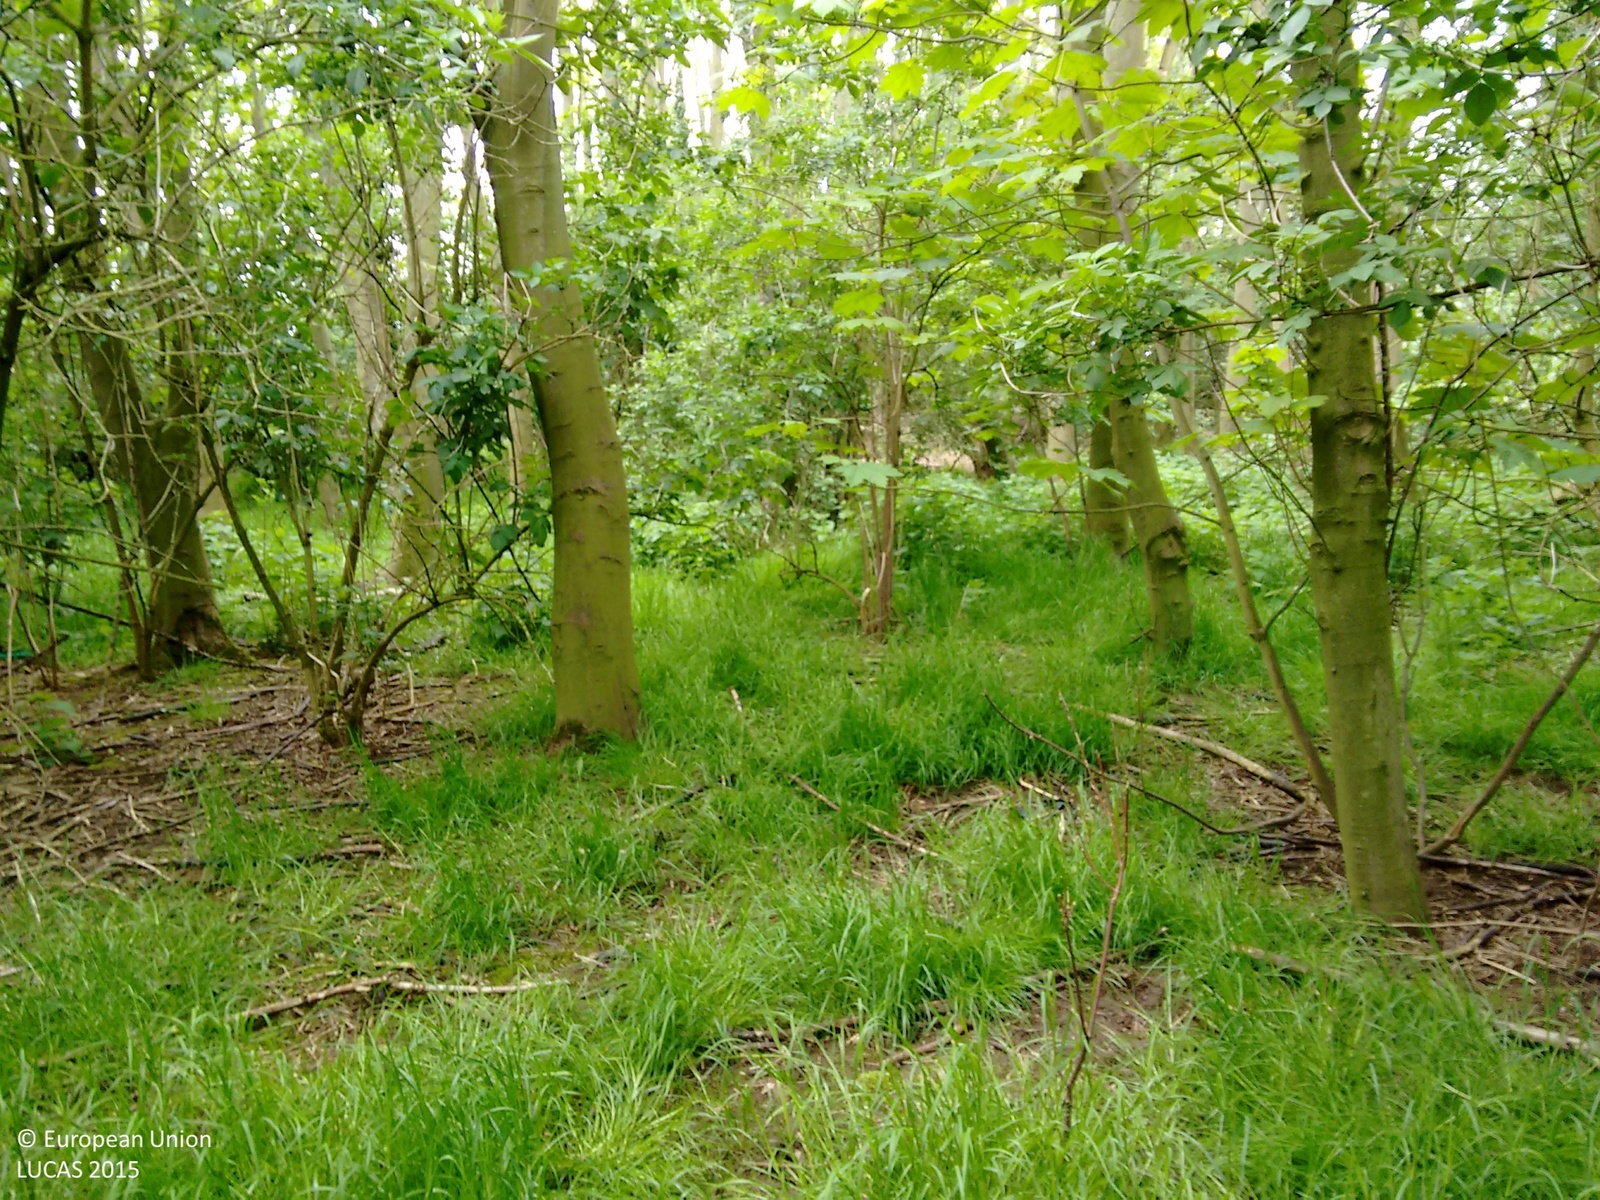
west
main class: Woodland
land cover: Broadleaved woodland
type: mesophytic deciduous forest
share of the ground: > 75 %
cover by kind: broadleaved forest trees 100 %
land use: Agriculture (excluding fallow land and kitchen gardens)
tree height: > 5 m
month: May
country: GB
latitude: 53.1005
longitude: 0.2777
